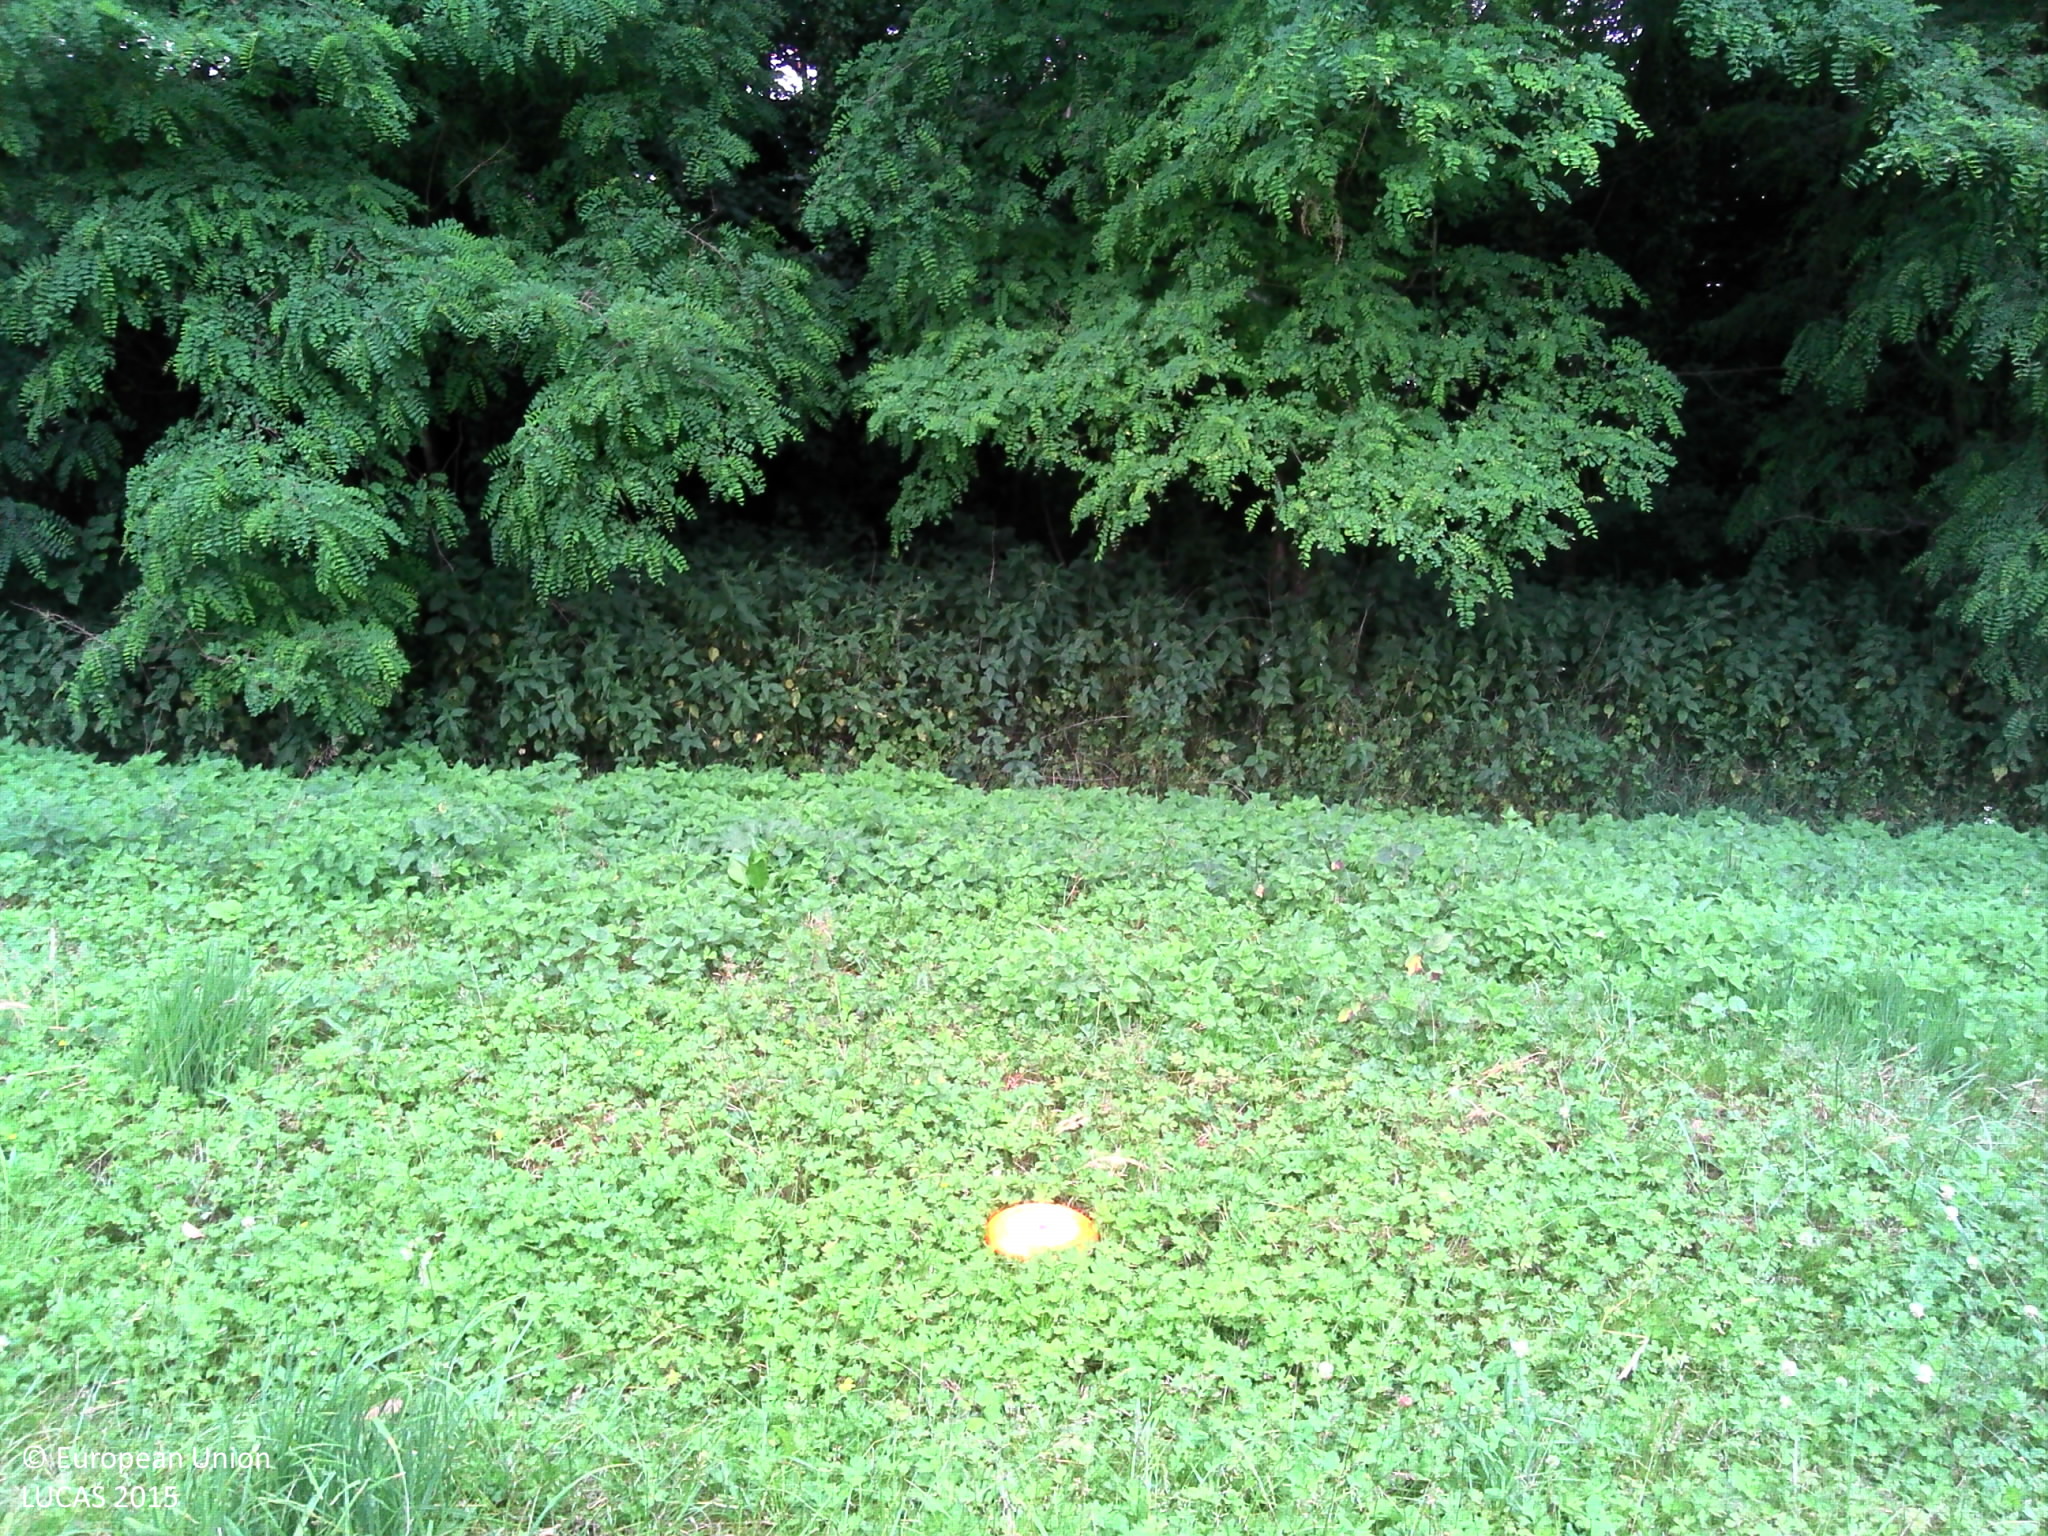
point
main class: Grassland
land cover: Grassland without tree/shrub cover
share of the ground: > 75 %
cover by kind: herbaceous plants 100 %
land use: Agriculture (excluding fallow land and kitchen gardens)
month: June
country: FR
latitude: 46.0645
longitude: 4.8448
